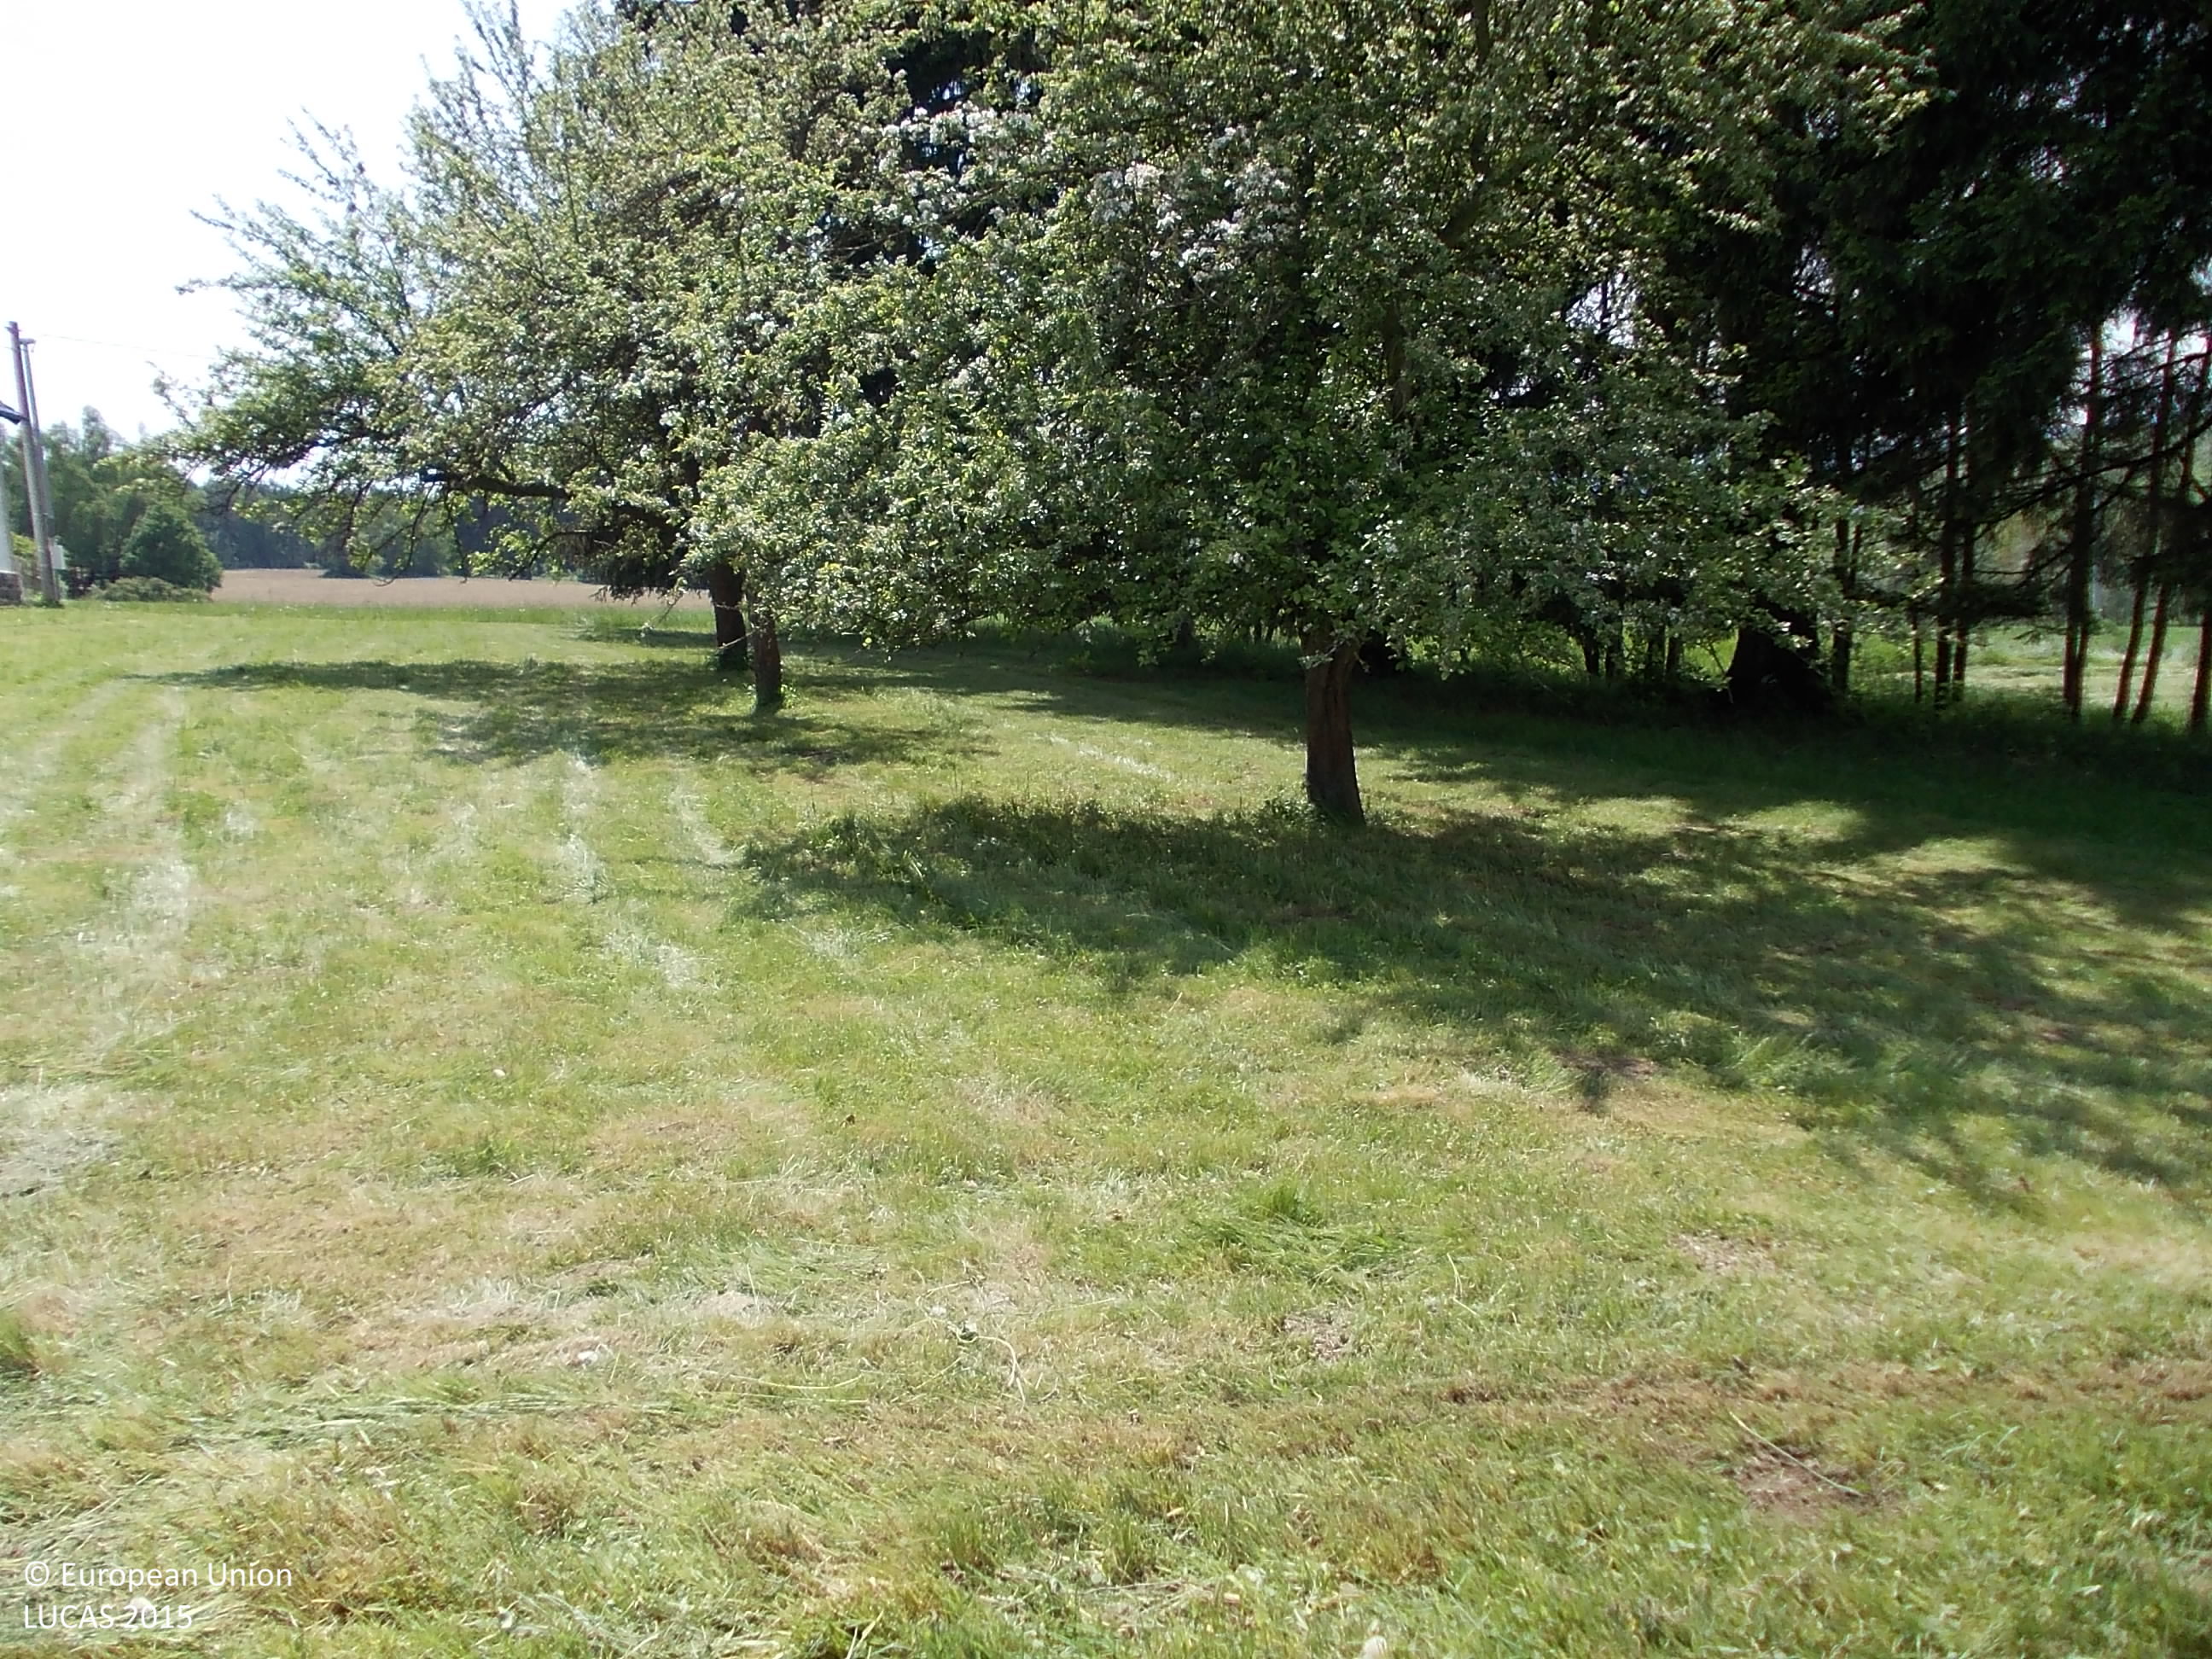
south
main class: Grassland
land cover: Grassland without tree/shrub cover
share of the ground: > 75 %
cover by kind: herbaceous plants 100 %
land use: Agriculture (excluding fallow land and kitchen gardens)
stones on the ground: < 10 %
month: May
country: CZ
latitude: 49.1335
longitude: 13.7144
